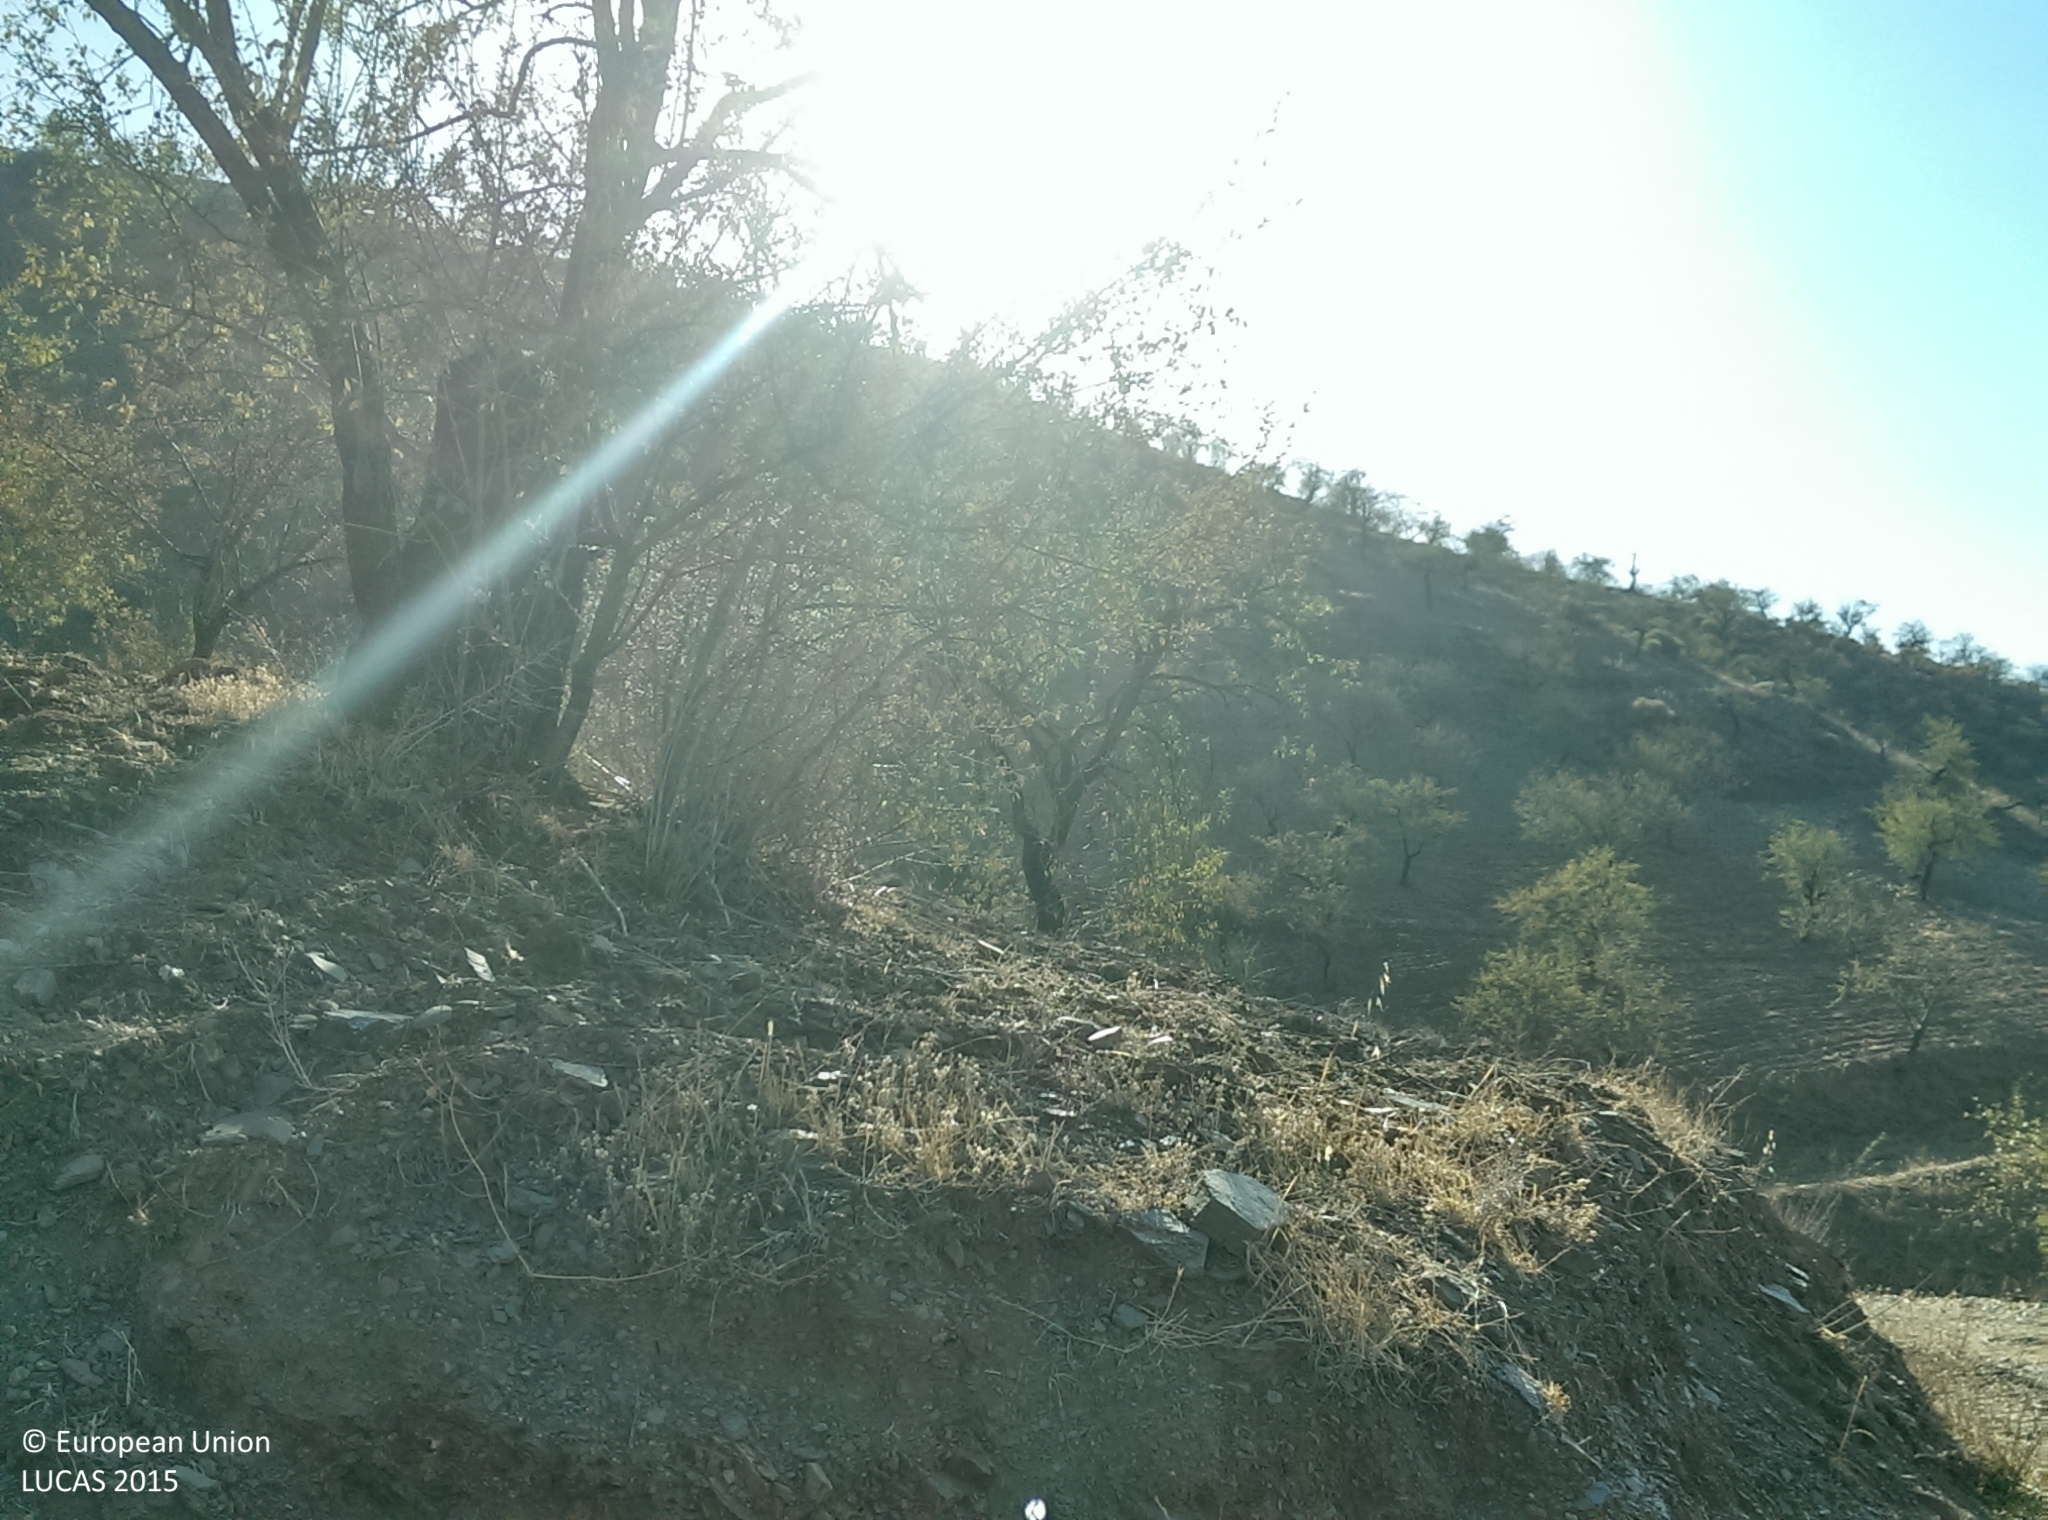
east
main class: Cropland
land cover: Nuts trees
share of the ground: 25 - 50 %
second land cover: Other bare soil
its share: > 75 %
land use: Agriculture (excluding fallow land and kitchen gardens)
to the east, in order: Nuts trees; Other bare soil; Broadleaved woodland; Shrubland with sparse tree cover; Nuts trees; Tracks; Nuts trees; Shrubland with sparse tree cover; Nuts trees
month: August
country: ES
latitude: 36.7906
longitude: -3.1692
